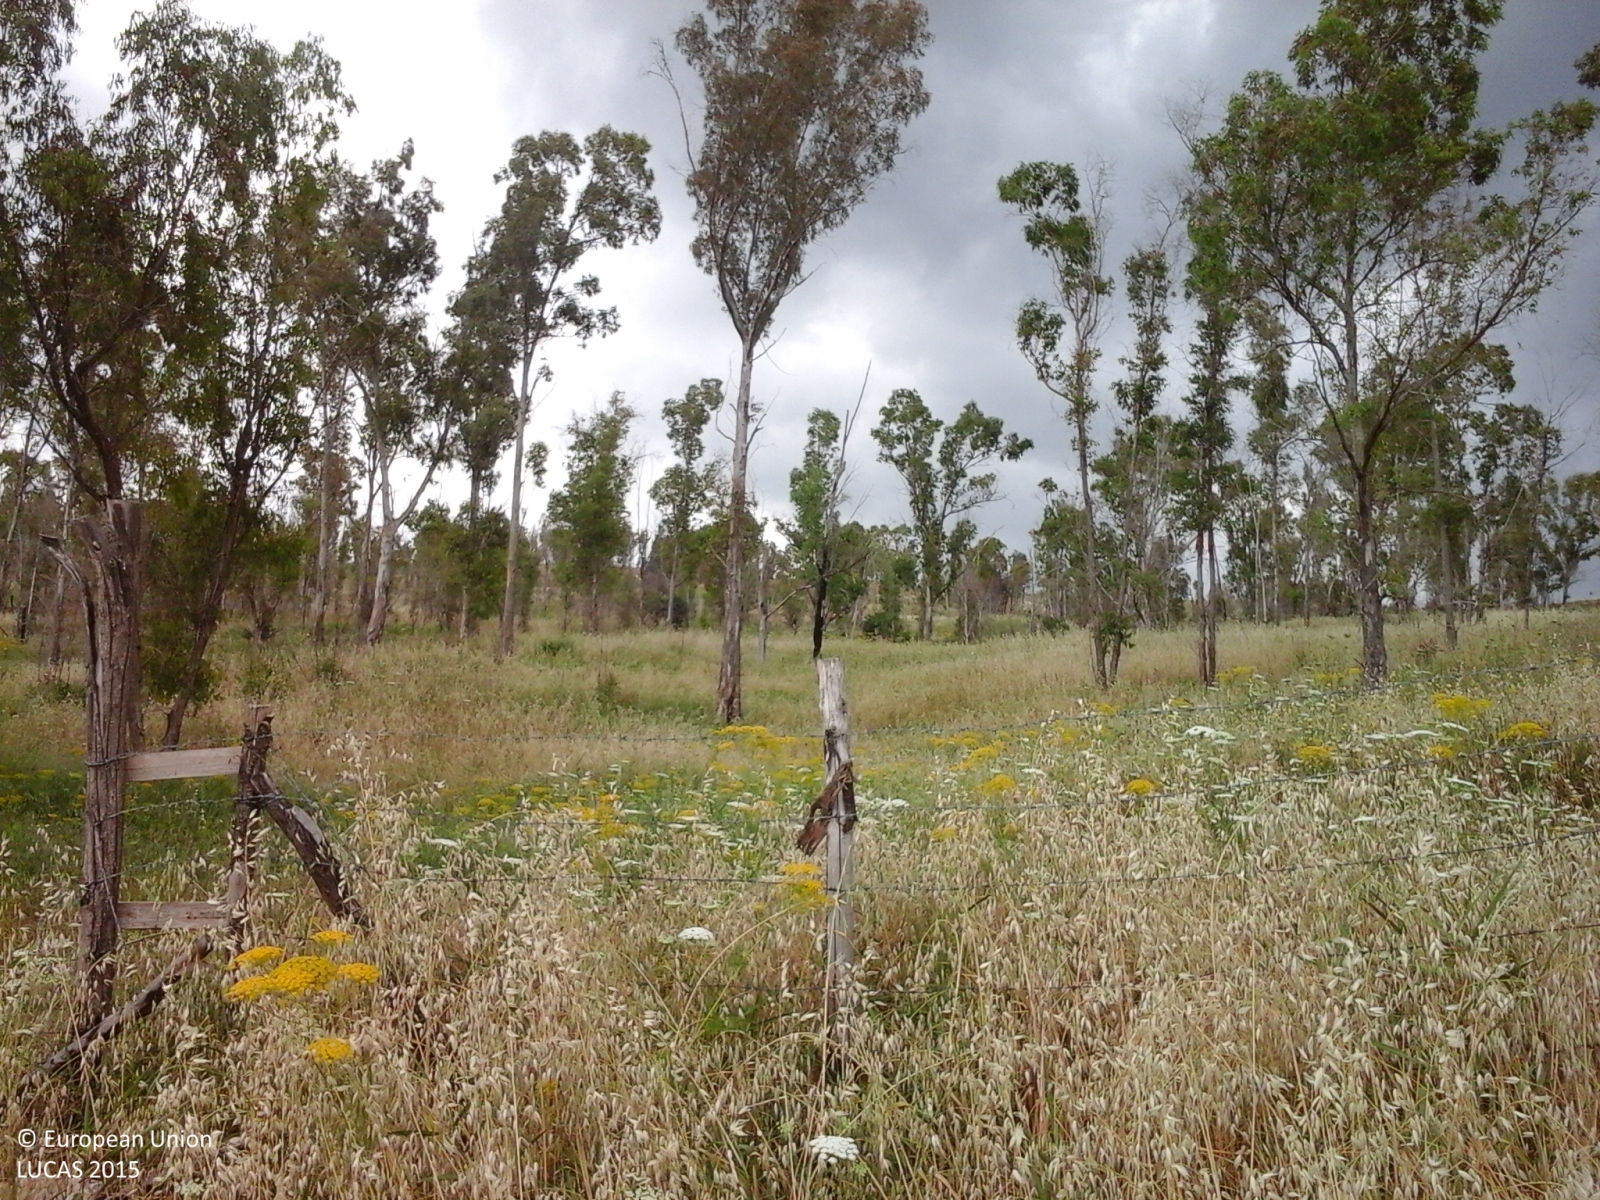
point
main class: Woodland
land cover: Broadleaved woodland
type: broadleaved evergreen forest
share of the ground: 25 - 50 %
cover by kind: herbaceous plants 60 %, broadleaved forest trees 40 %
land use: Forestry
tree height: > 5 m
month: June
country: IT
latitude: 37.5165
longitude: 13.5820
